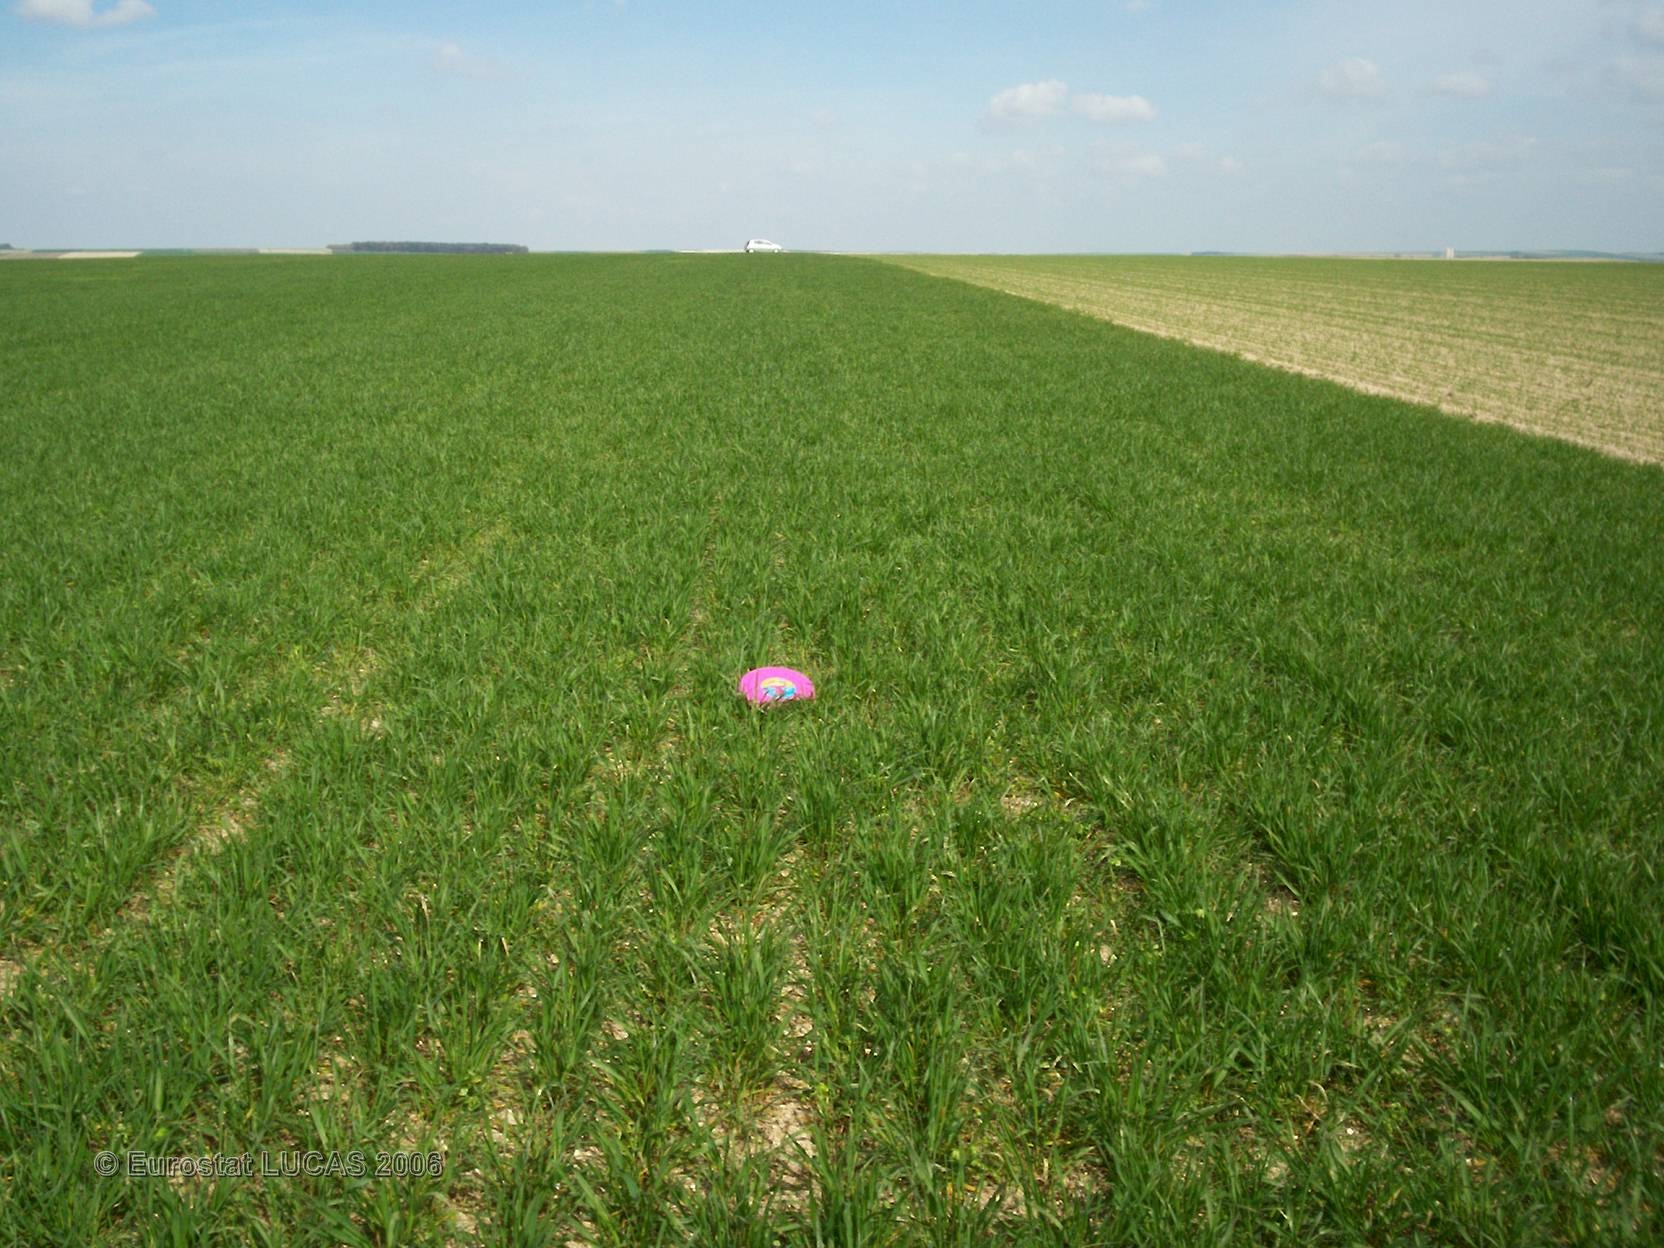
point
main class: Cropland
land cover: Barley
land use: Agriculture (excluding fallow land and kitchen gardens)
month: April
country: FR
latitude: 49.1985
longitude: 4.3832
